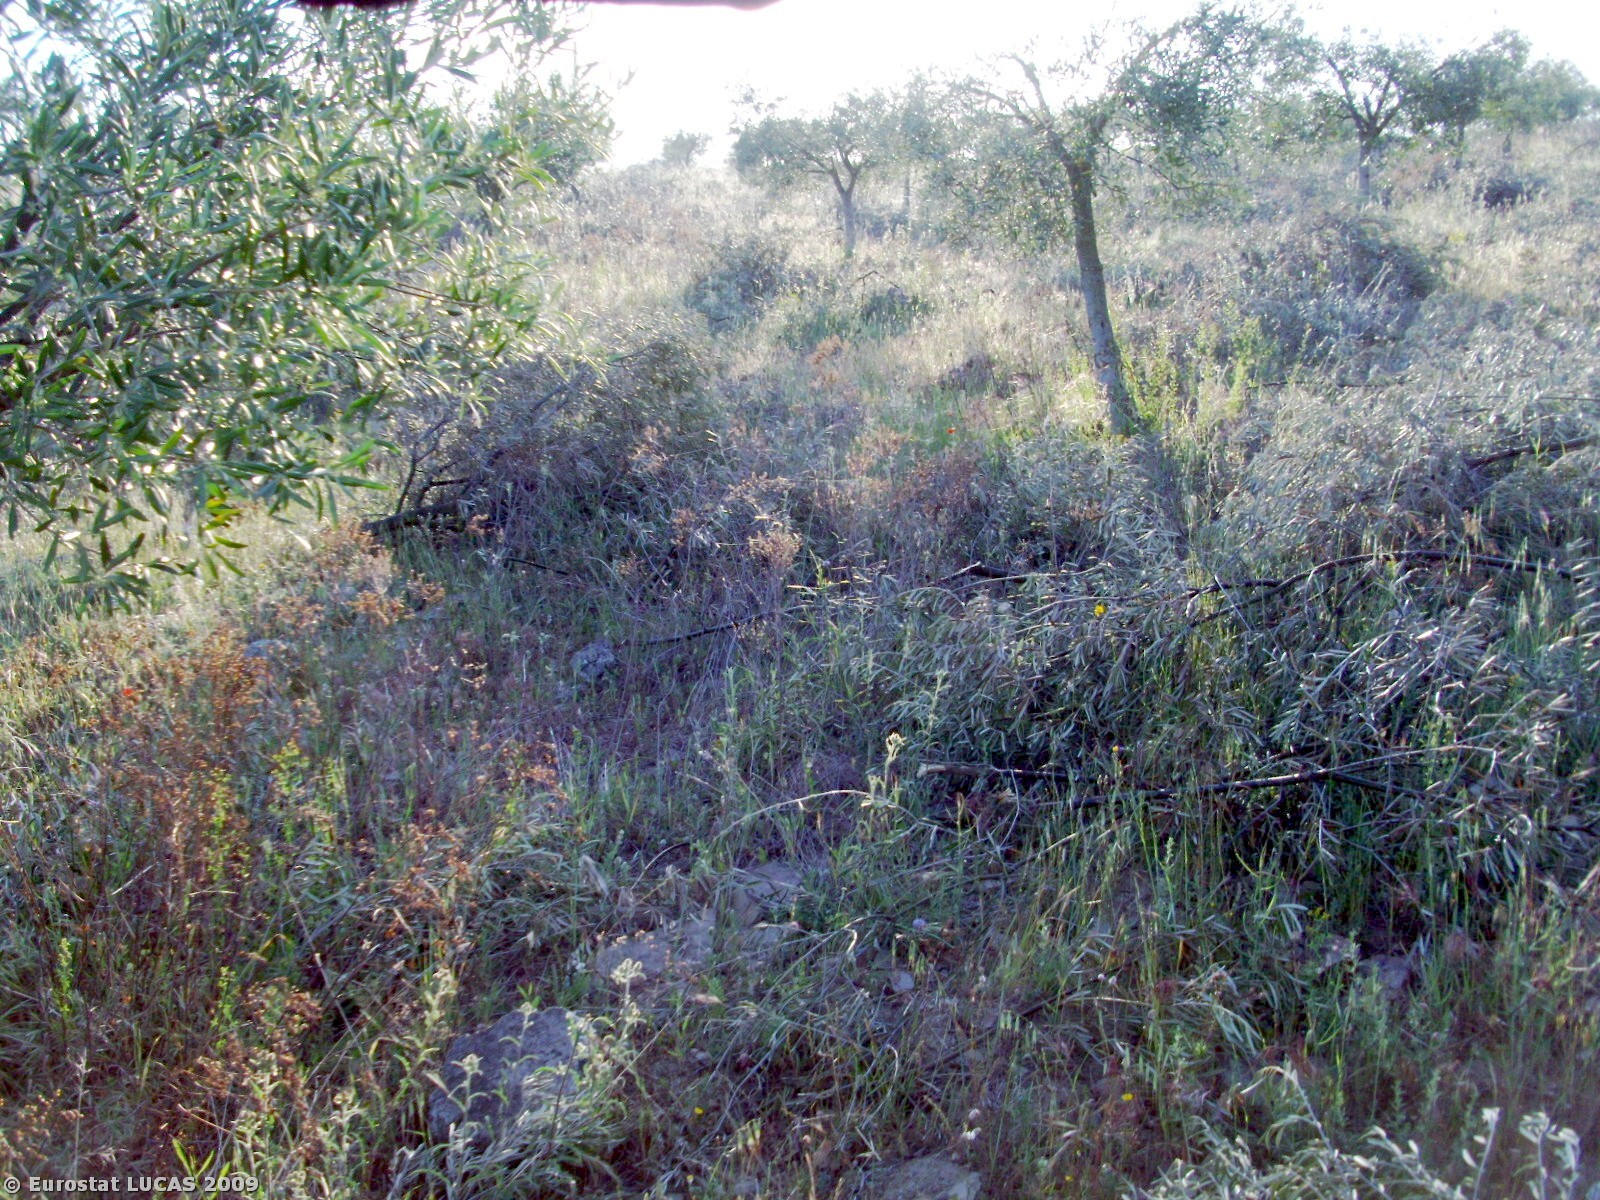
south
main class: Cropland
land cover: Olive groves
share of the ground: 25 - 50 %
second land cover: Spontaneously vegetated surfaces
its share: > 75 %
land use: Agriculture (excluding fallow land and kitchen gardens)
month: May
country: PT
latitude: 41.0570
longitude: -7.2114
